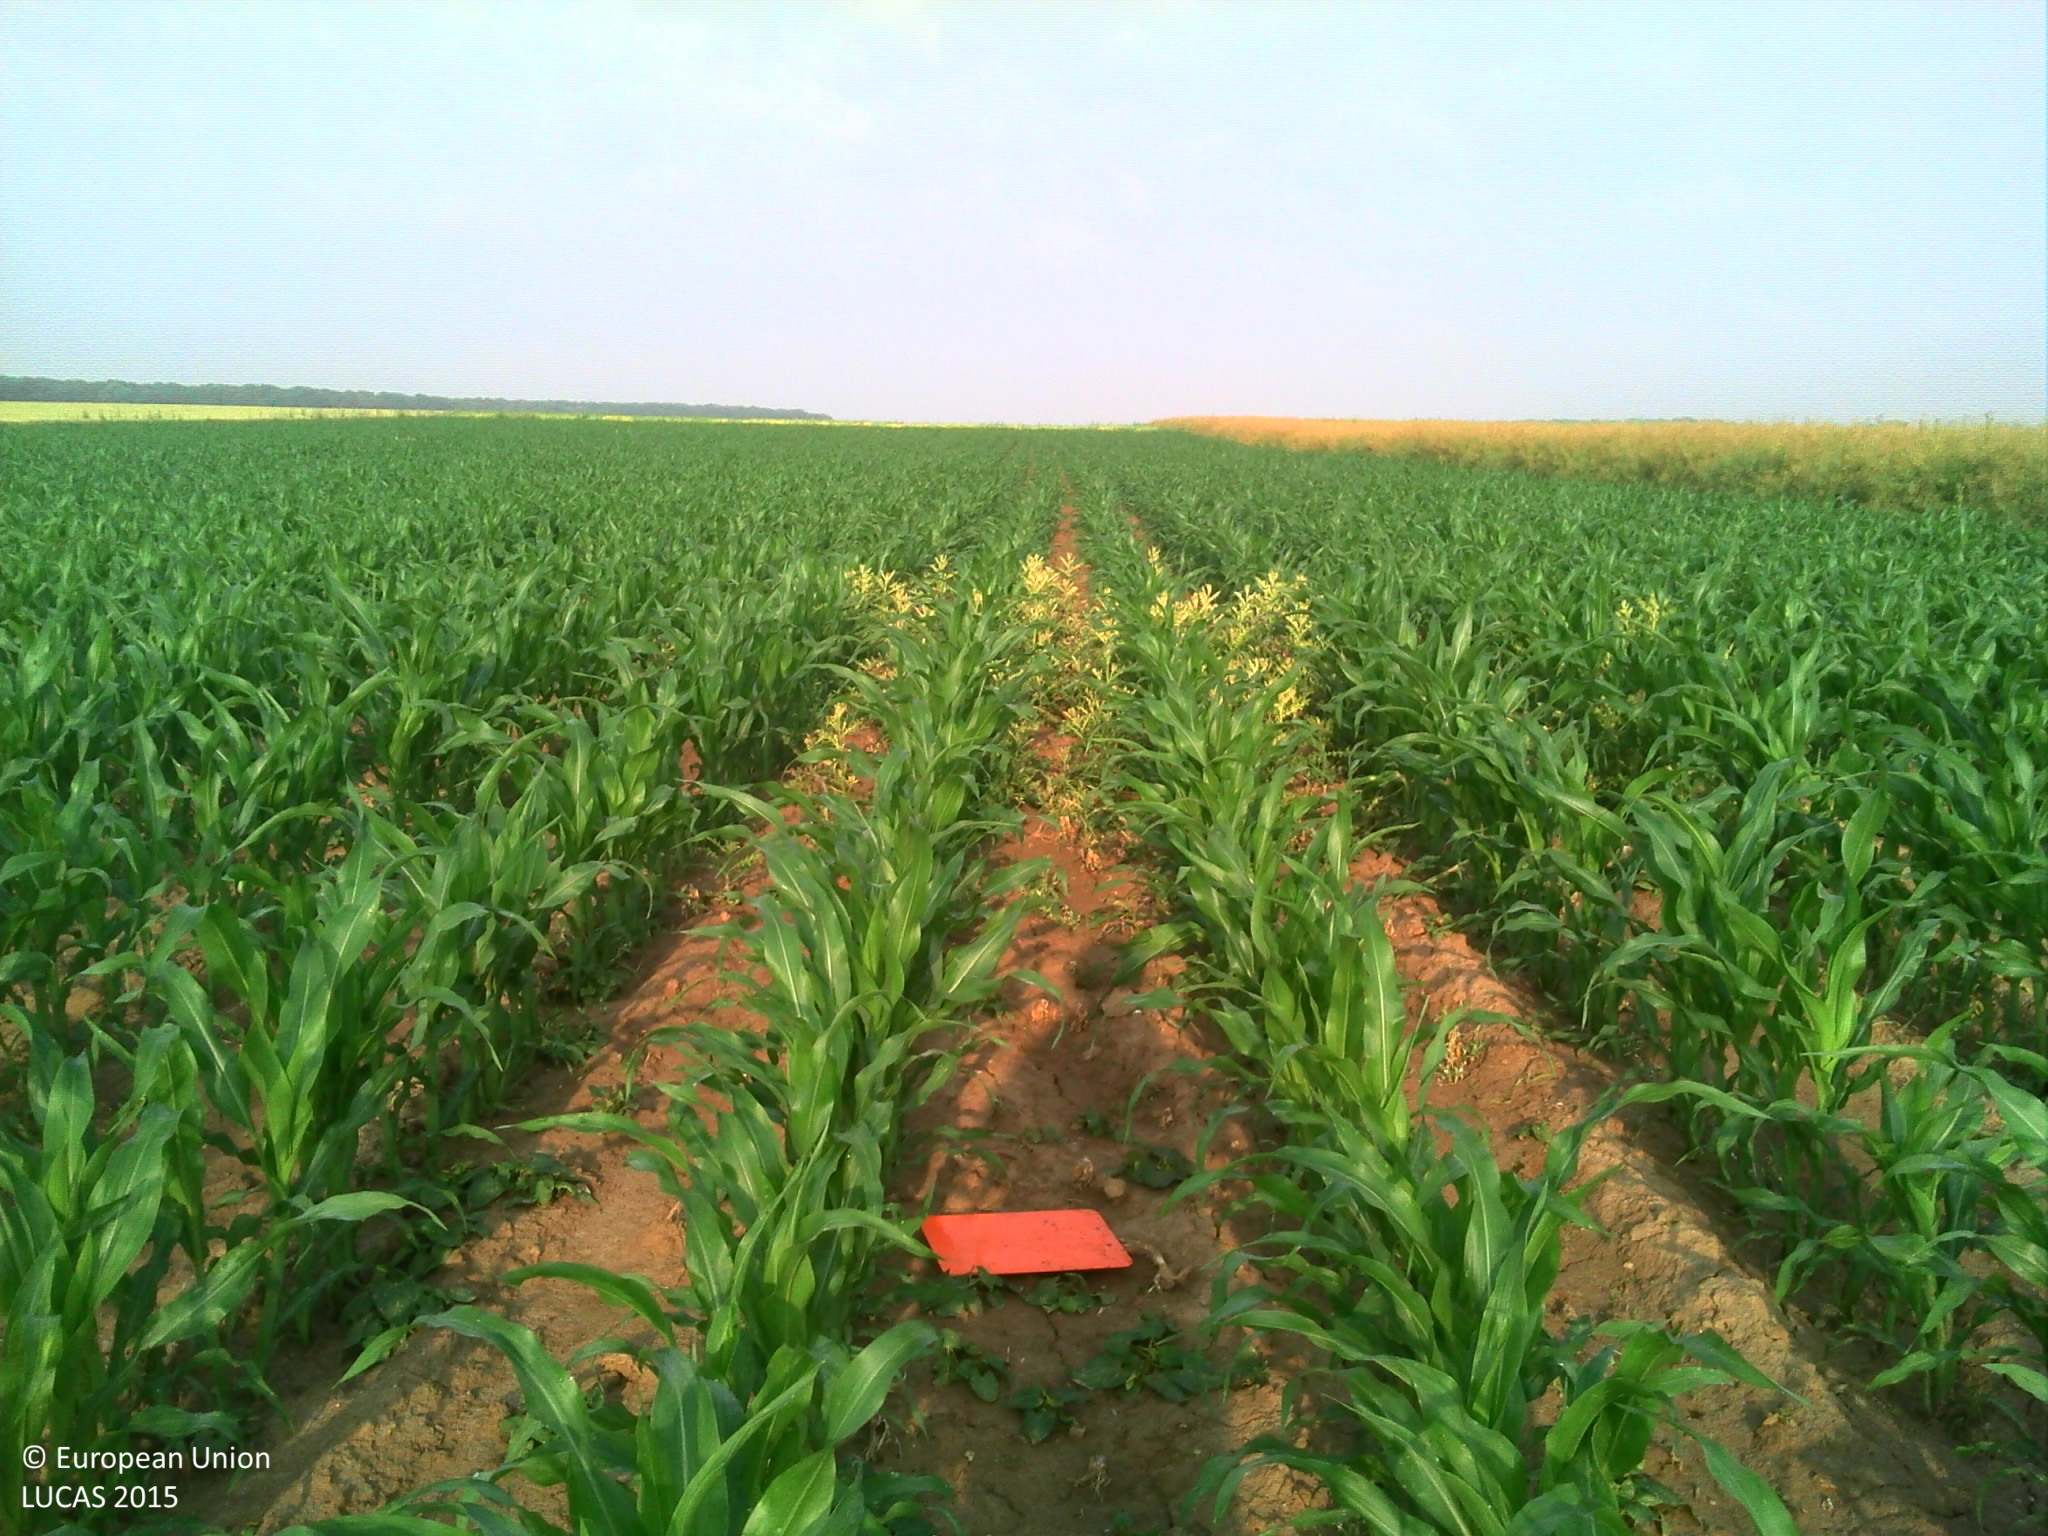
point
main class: Cropland
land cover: Maize
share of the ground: 25 - 50 %
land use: Agriculture (excluding fallow land and kitchen gardens)
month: July
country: FR
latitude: 49.7426
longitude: 2.5640
